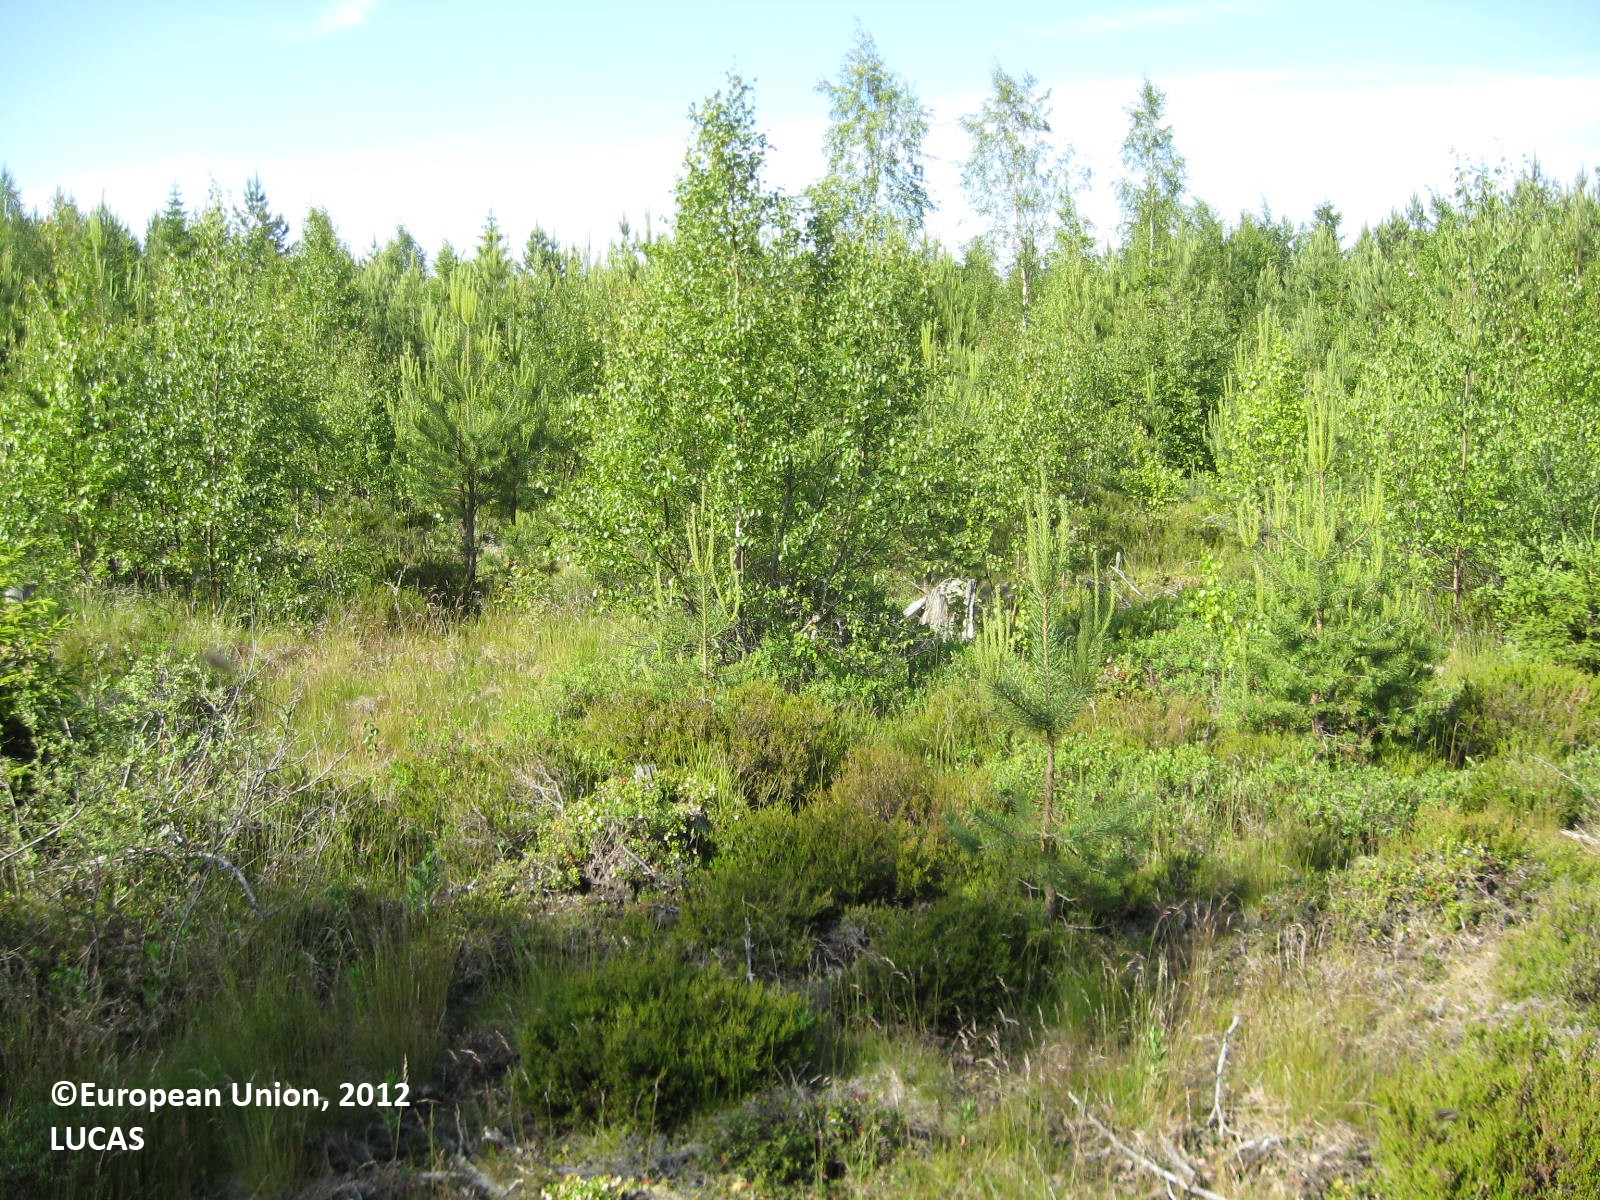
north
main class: Woodland
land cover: Other mixed woodland
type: boreal forest
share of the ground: > 75 %
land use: Forestry
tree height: < 5 m
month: June
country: FI
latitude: 62.6247
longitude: 21.7612
